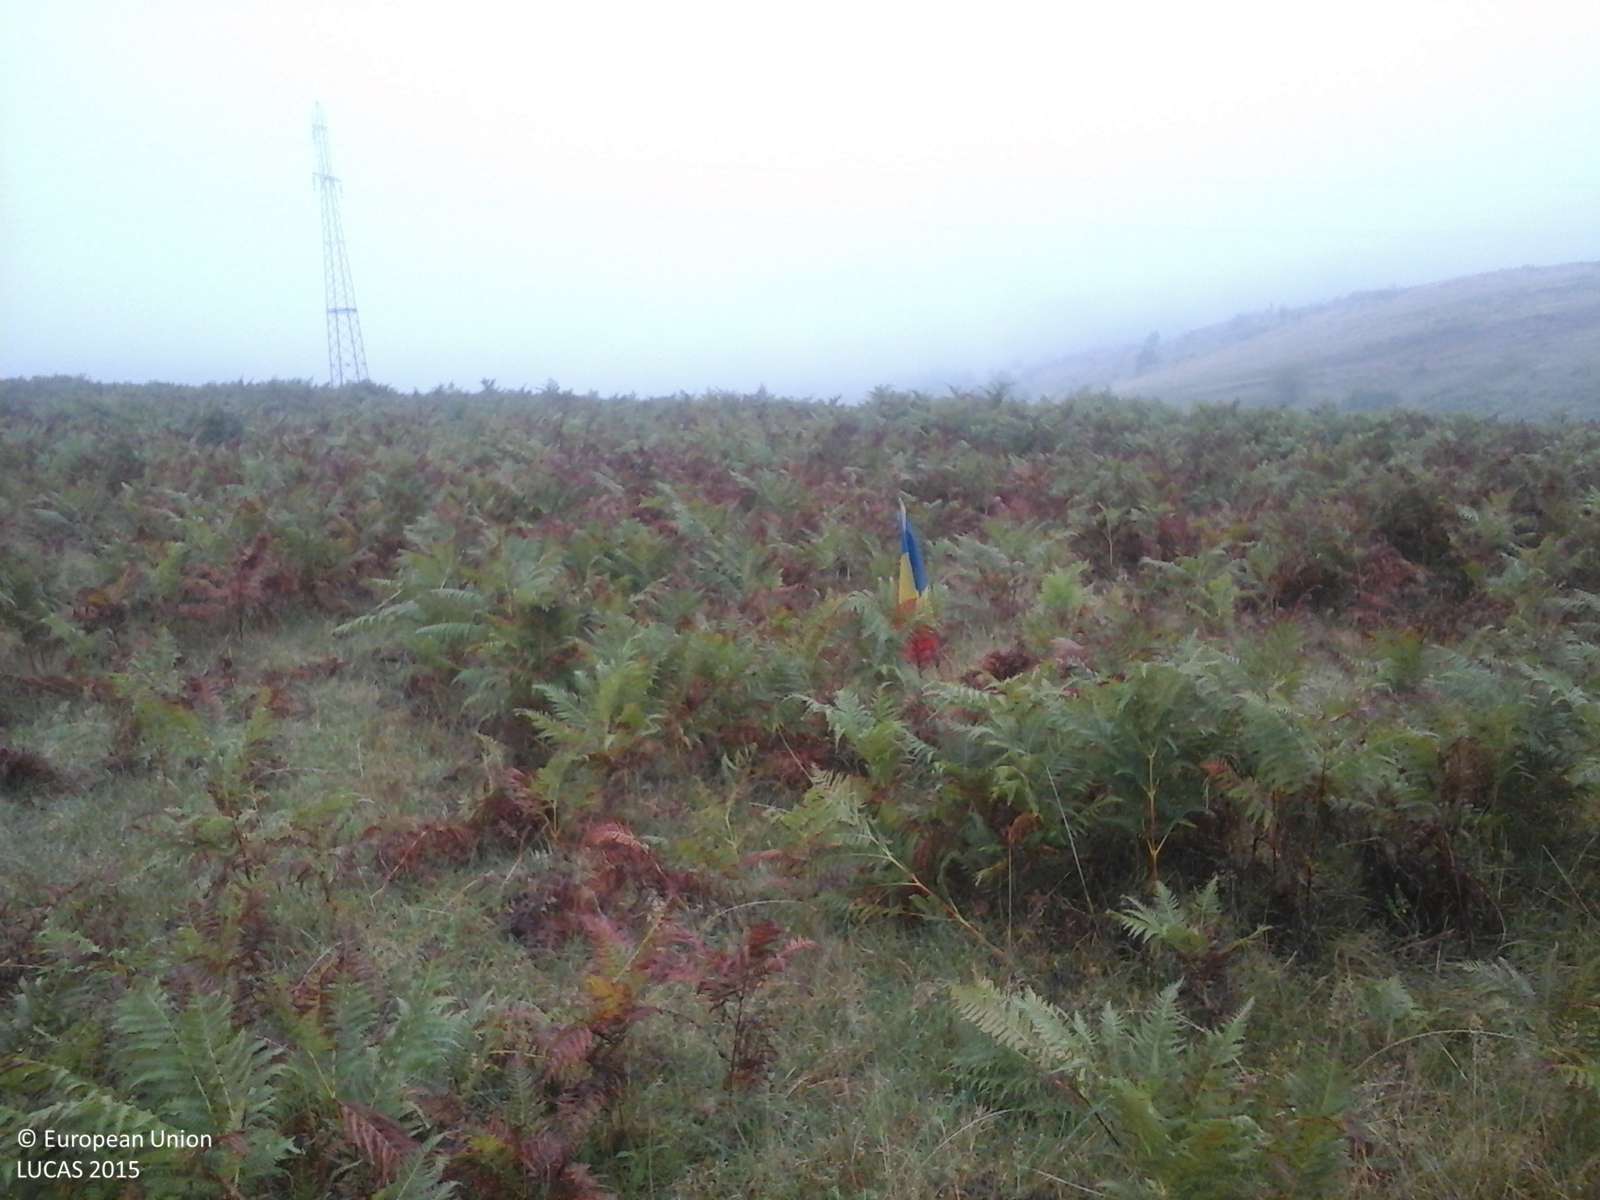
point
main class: Grassland
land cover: Spontaneously vegetated surfaces
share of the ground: > 75 %
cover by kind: herbaceous plants 100 %
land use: Agriculture (excluding fallow land and kitchen gardens)
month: September
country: RO
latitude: 46.9833
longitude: 22.4778
